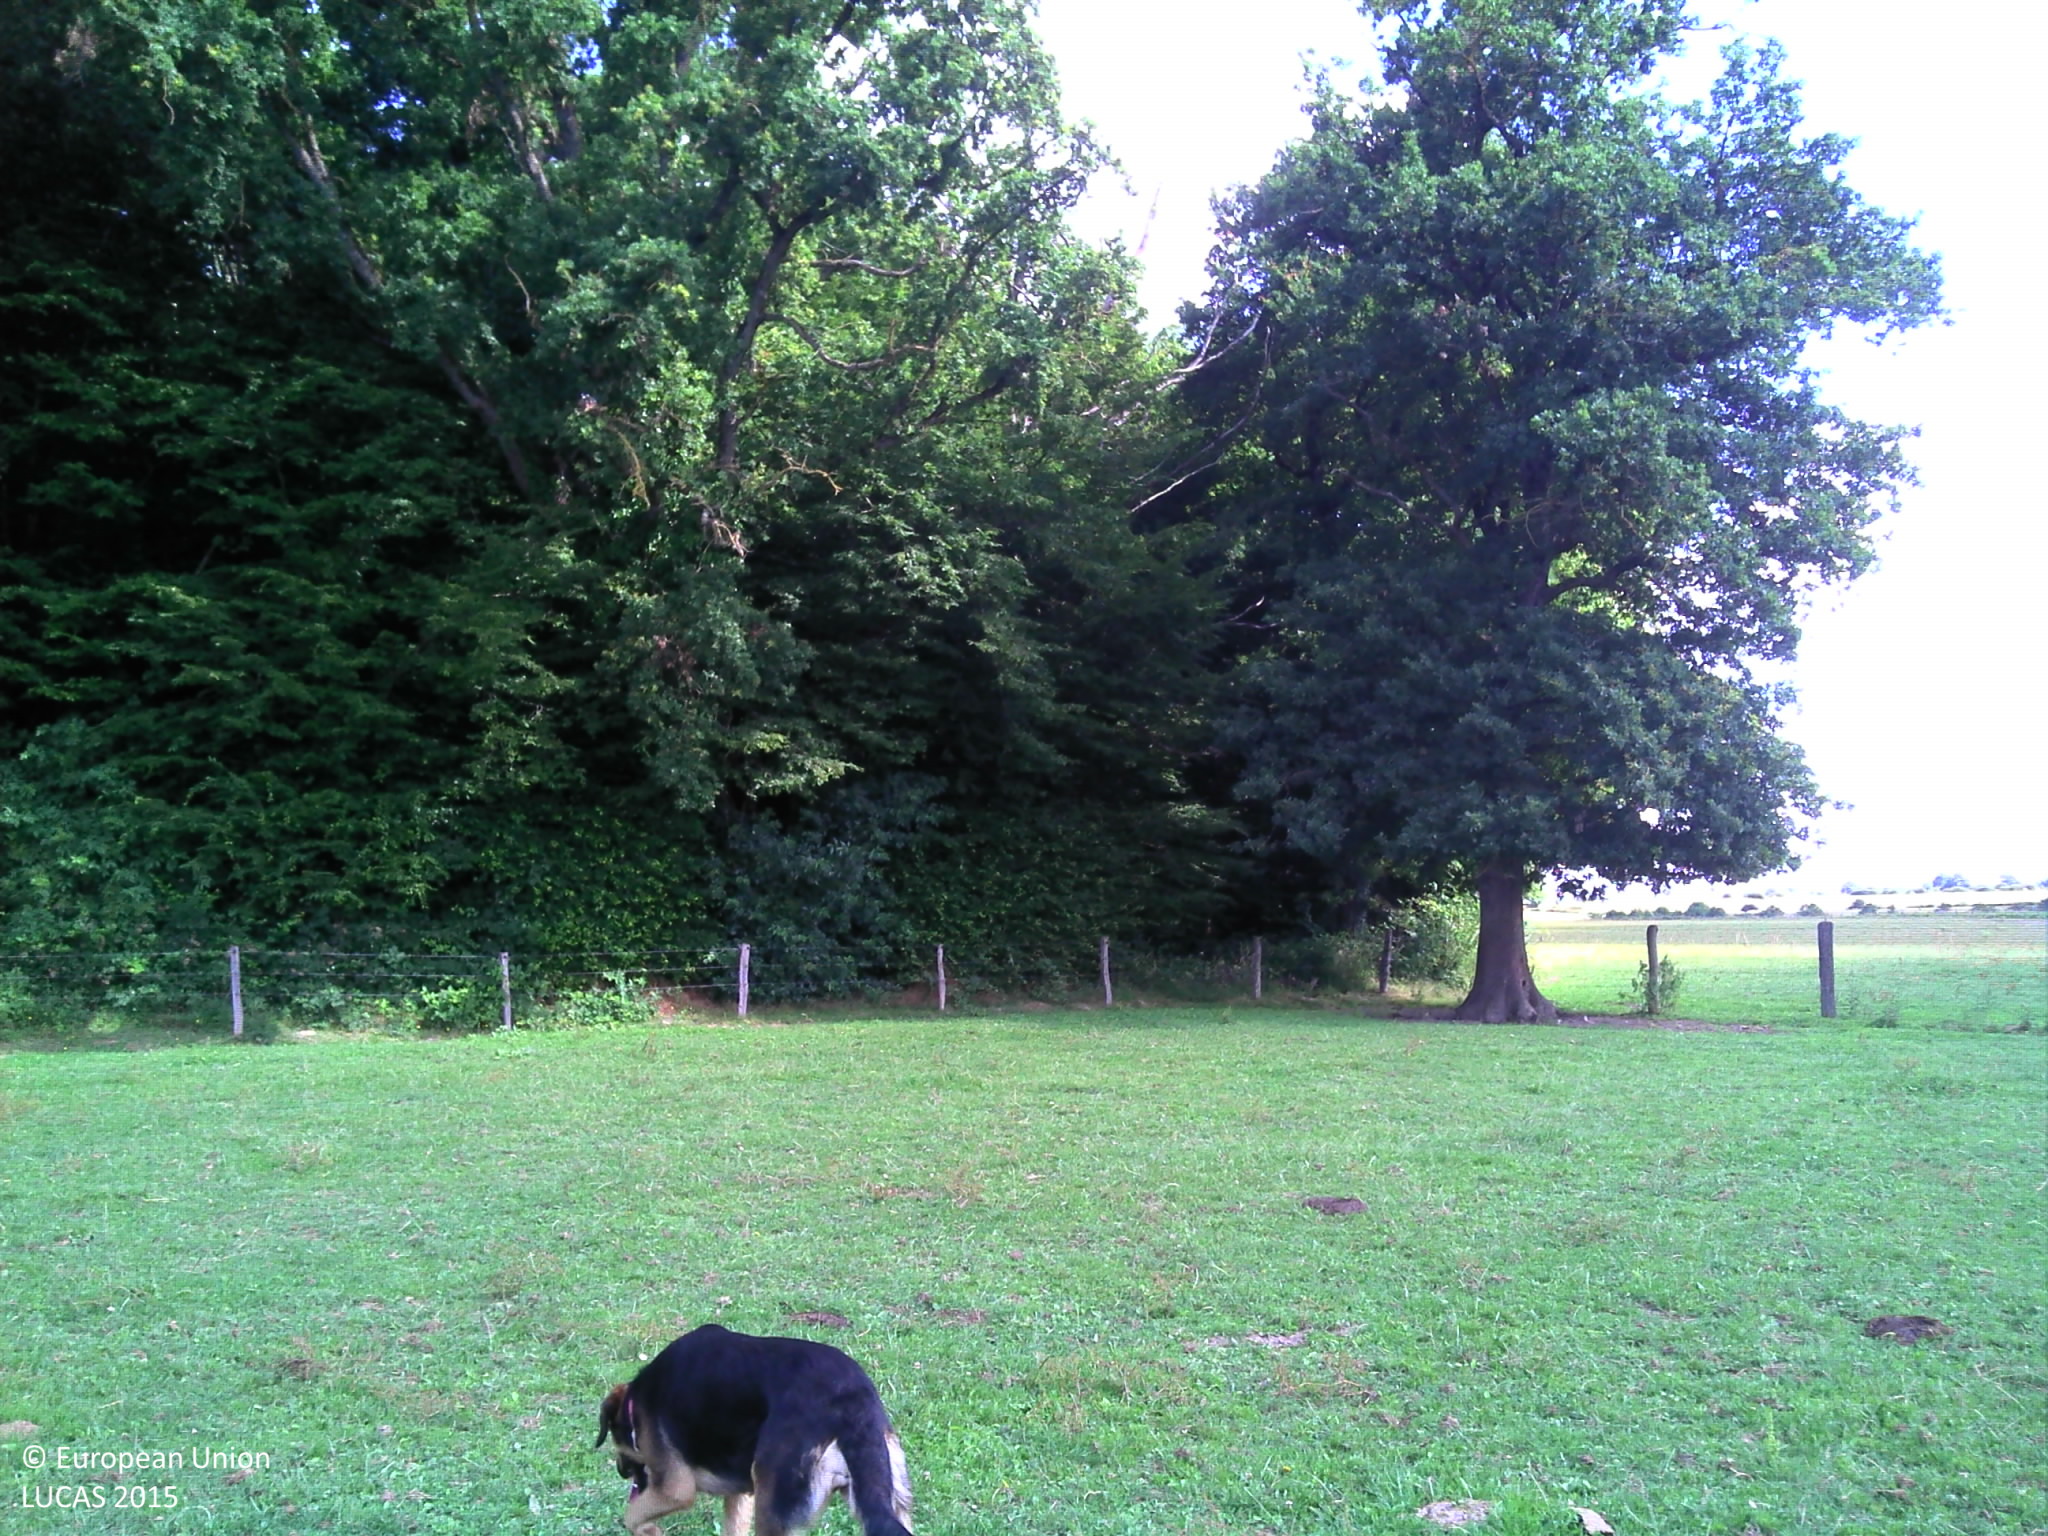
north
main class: Grassland
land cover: Grassland without tree/shrub cover
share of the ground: > 75 %
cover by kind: herbaceous plants 100 %
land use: Agriculture (excluding fallow land and kitchen gardens)
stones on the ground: < 10 %
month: June
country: FR
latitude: 46.7180
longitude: 3.5749
